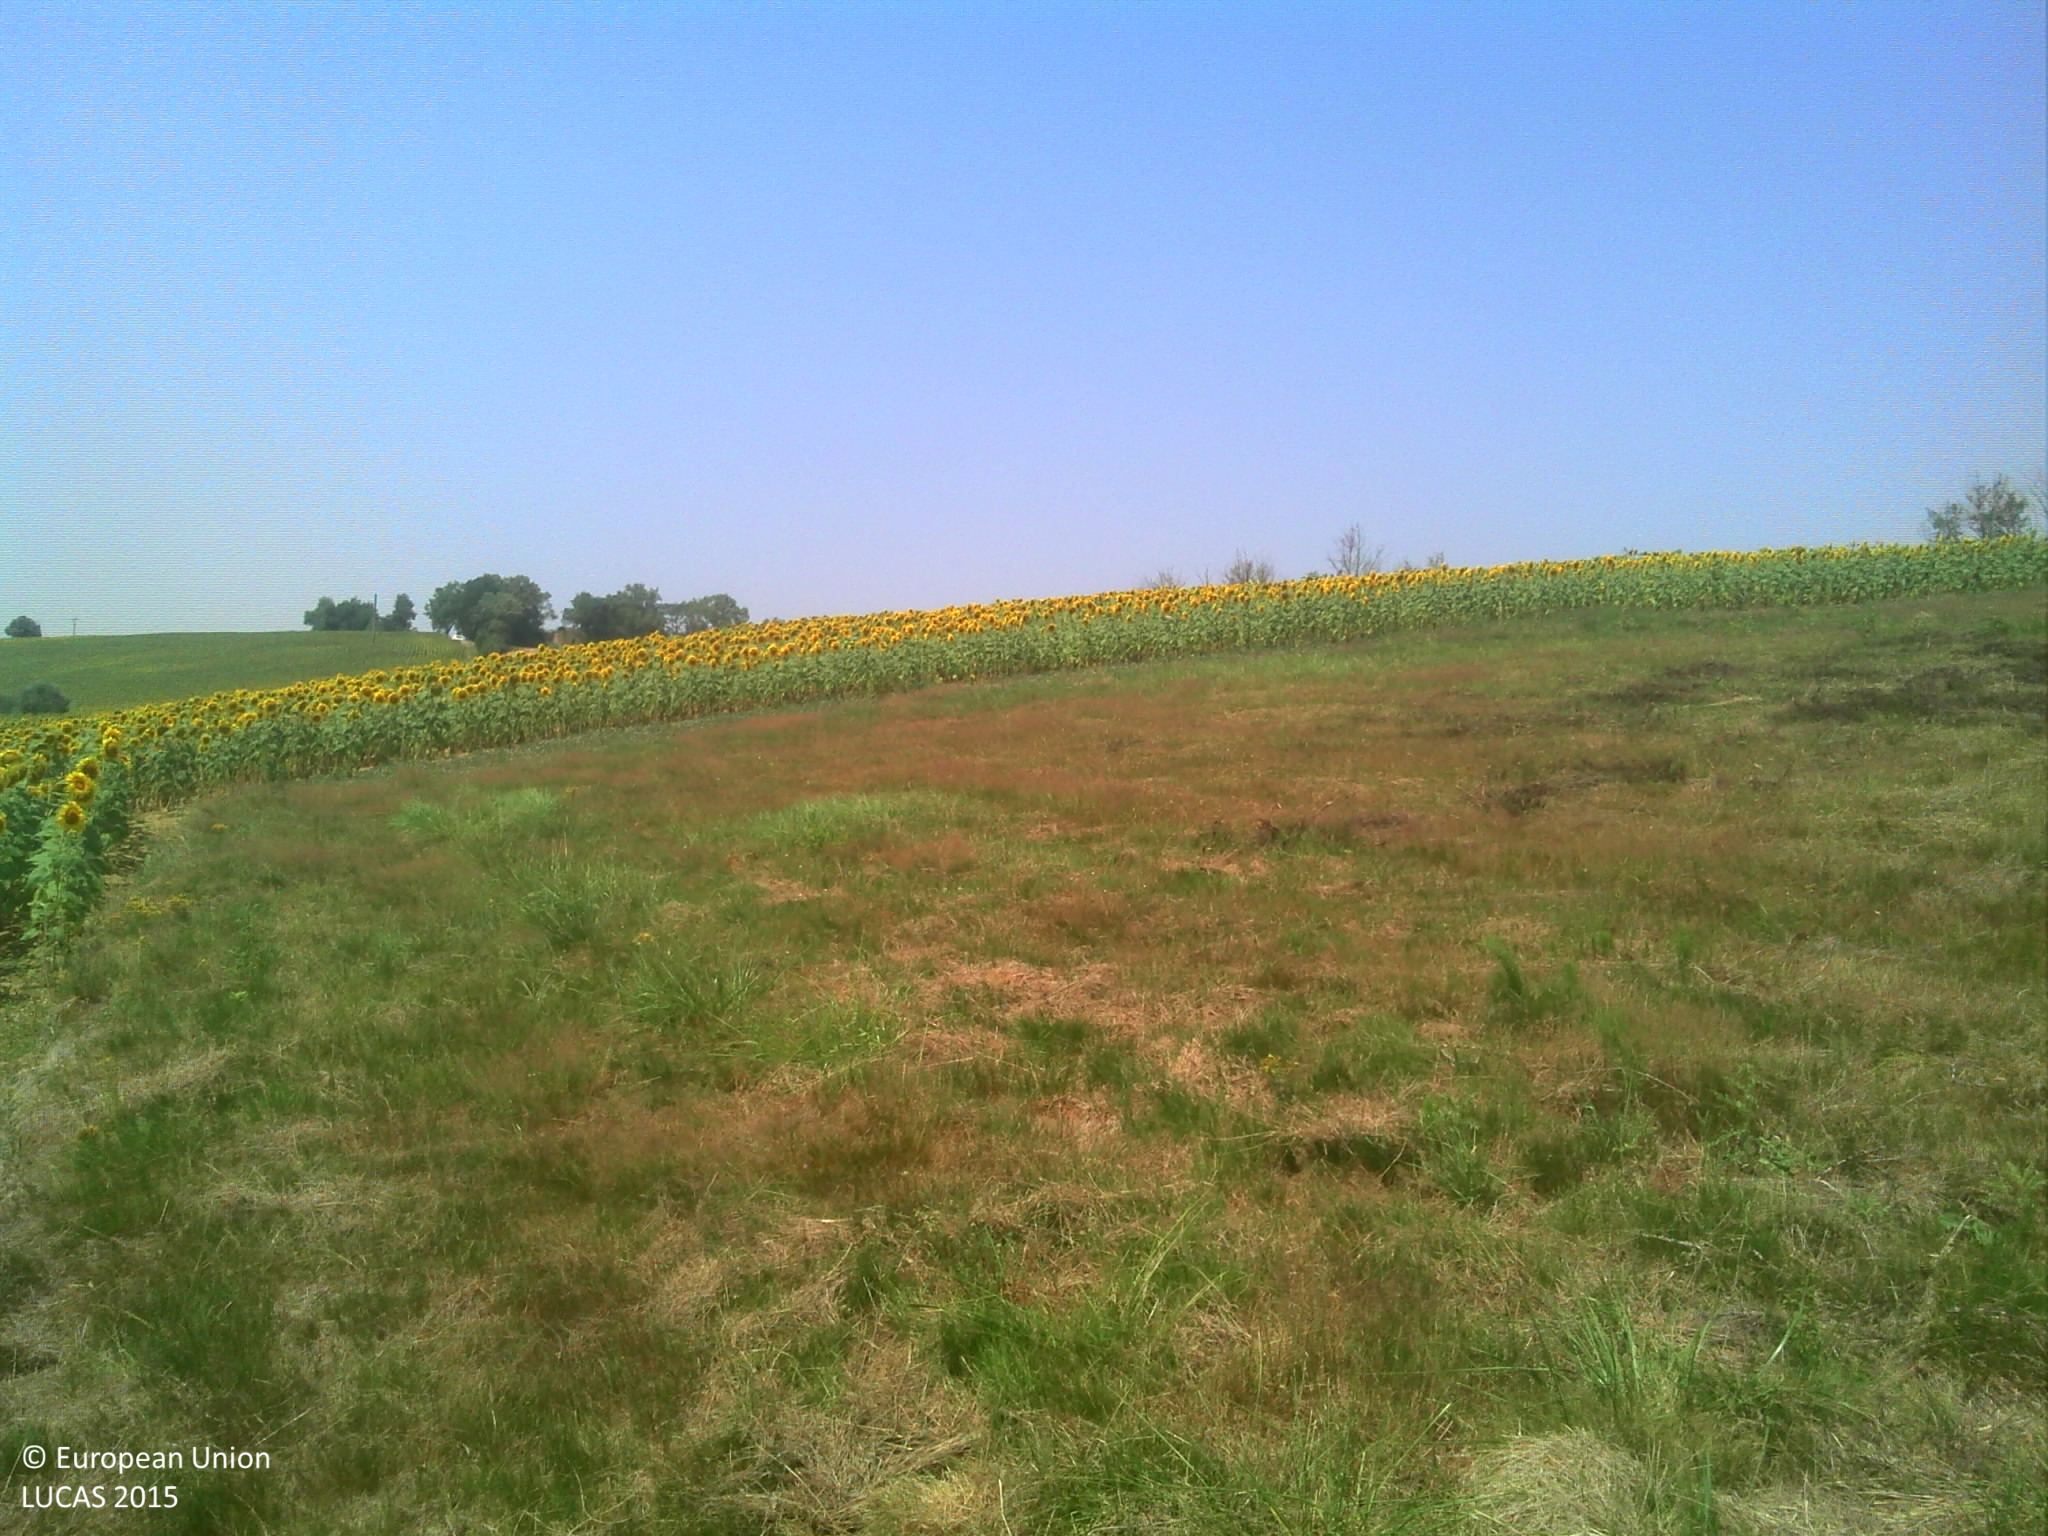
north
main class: Grassland
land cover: Grassland without tree/shrub cover
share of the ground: > 75 %
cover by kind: herbaceous plants 100 %
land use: Agriculture (excluding fallow land and kitchen gardens)
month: July
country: FR
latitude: 43.3807
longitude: 1.0283
